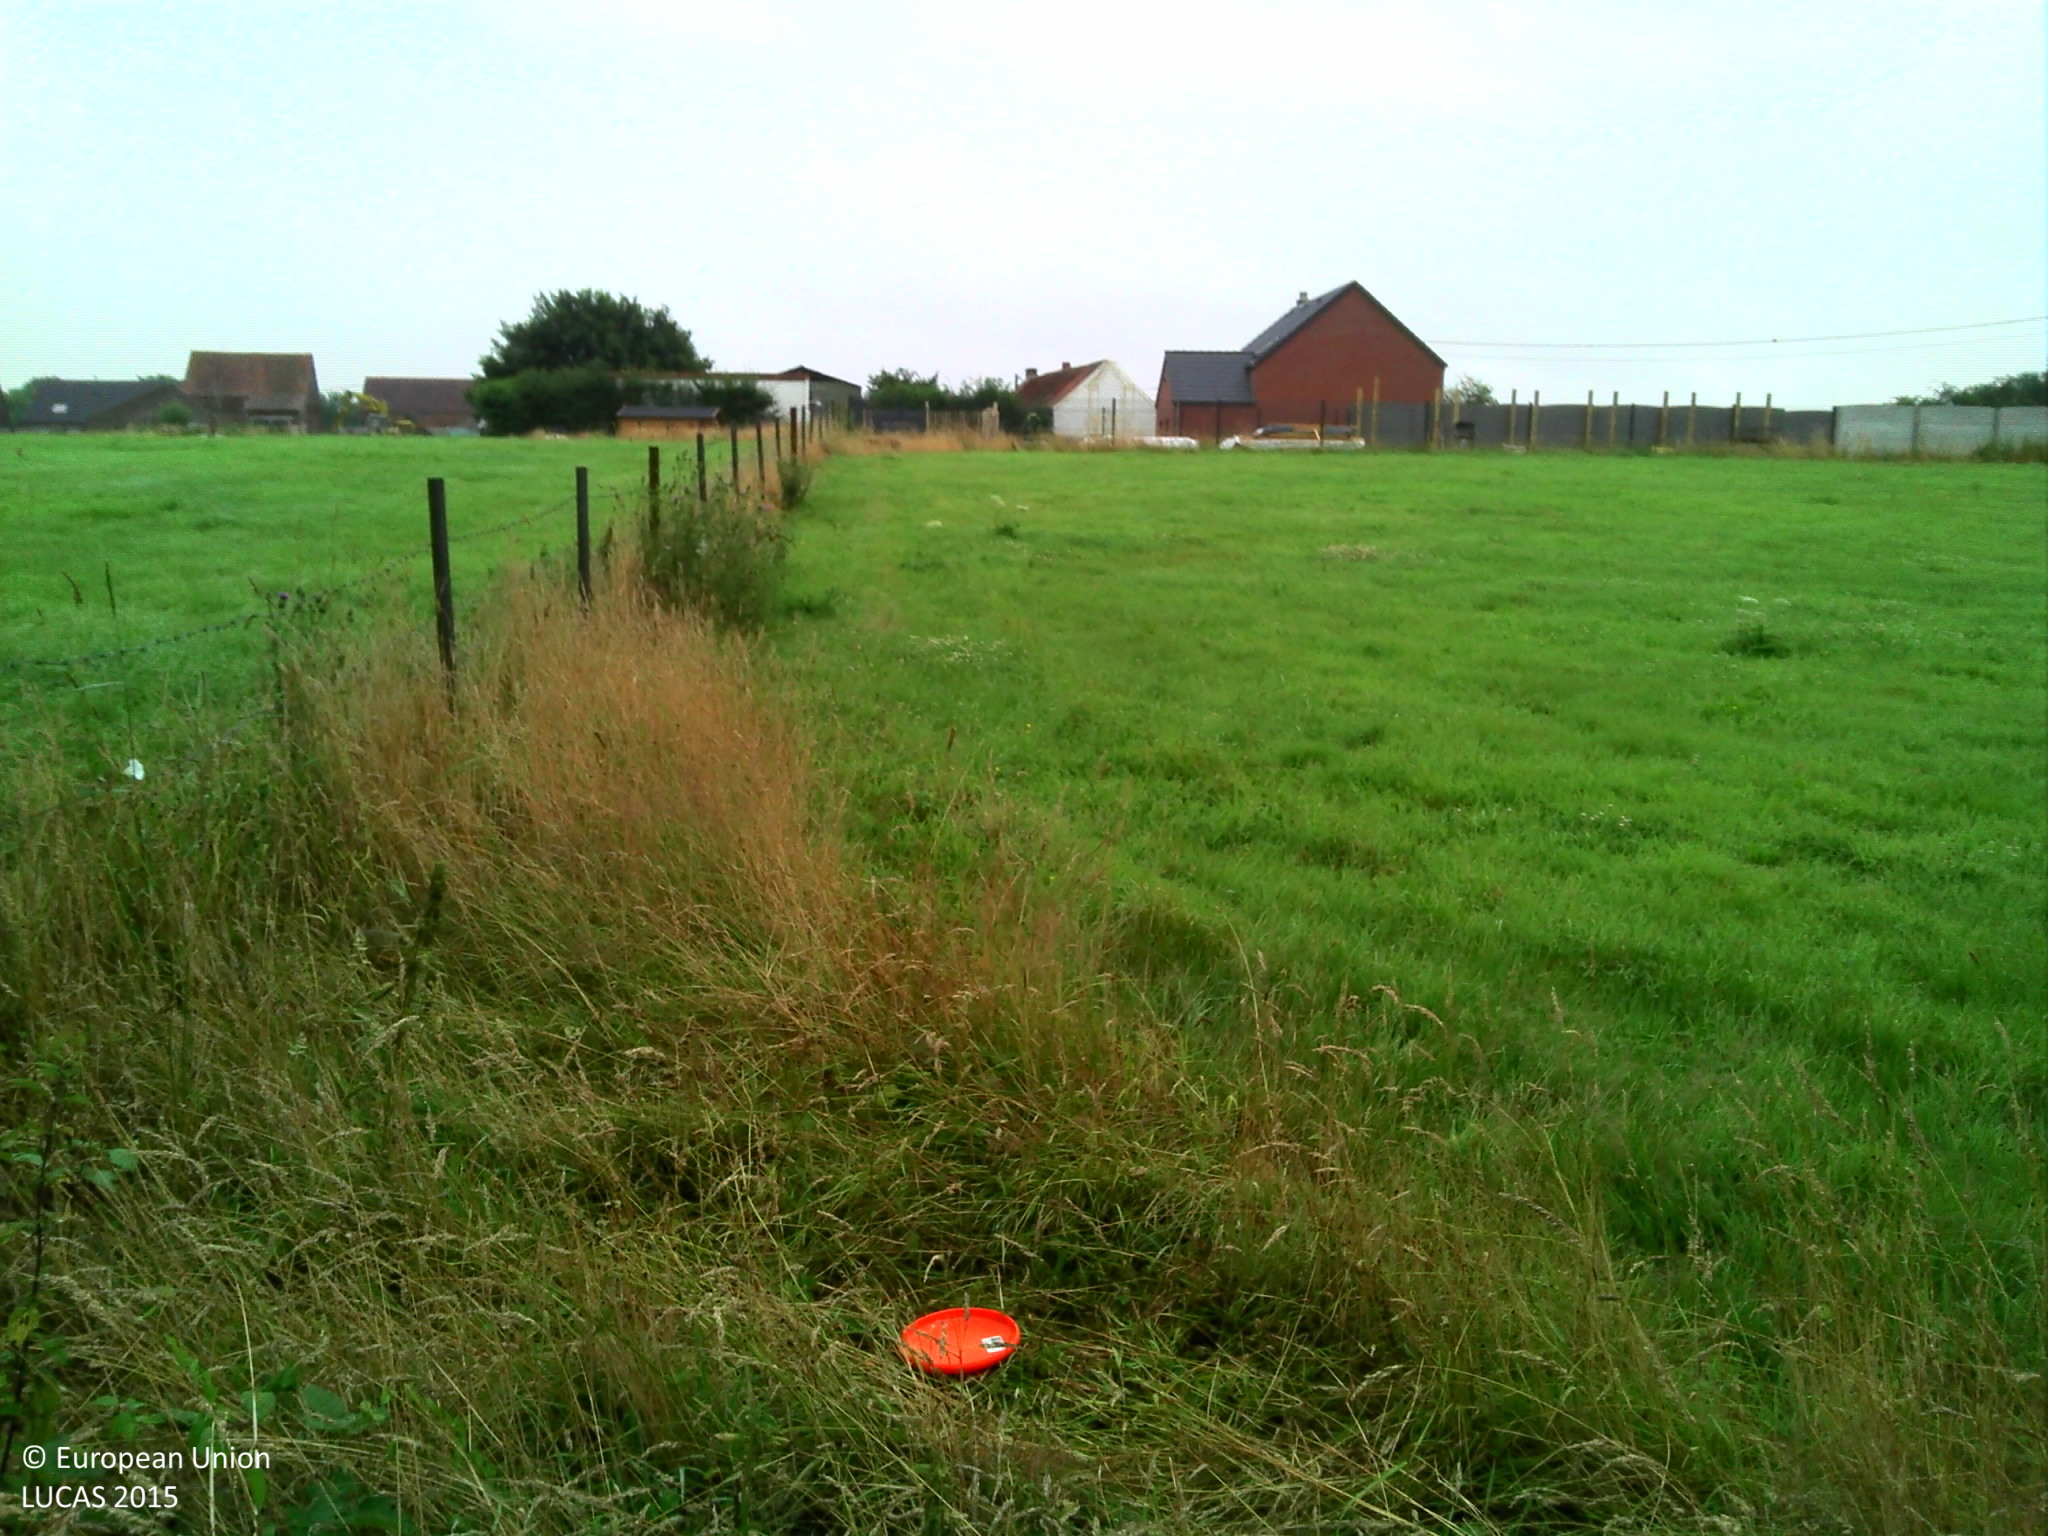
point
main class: Grassland
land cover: Grassland without tree/shrub cover
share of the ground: > 75 %
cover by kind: herbaceous plants 100 %
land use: Agriculture (excluding fallow land and kitchen gardens)
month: July
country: BE
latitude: 50.5818
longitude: 3.9353
